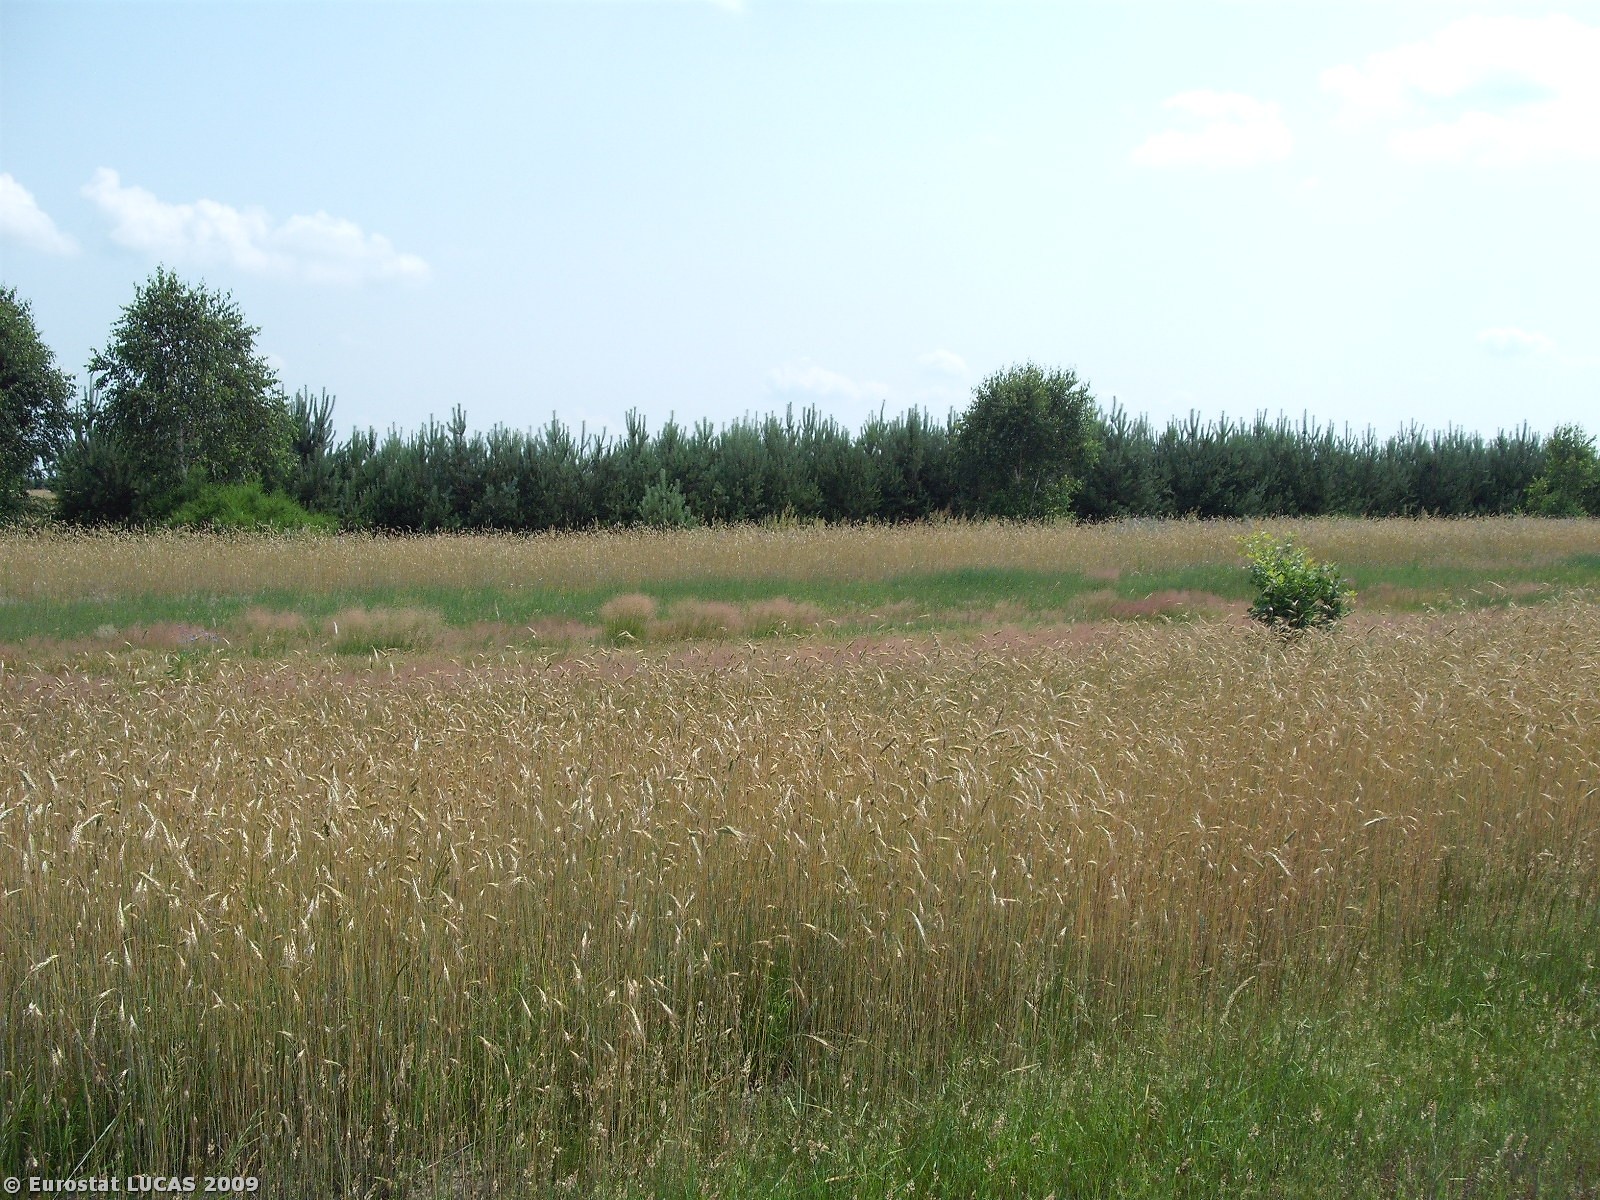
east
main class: Grassland
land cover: Spontaneously vegetated surfaces
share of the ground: > 75 %
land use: Fallow land
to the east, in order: Spontaneously vegetated surfaces; Rye; Spontaneously vegetated surfaces; Tracks; Spontaneously vegetated surfaces; Rye; Mixed woodland; Rye; Grassland without tree/shrub cover; Triticale; Tracks; Maize; Rye; Grassland without tree/shrub cover; Rye; Oats; Rye; Grass margins
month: July
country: PL
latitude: 51.4492
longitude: 20.5869
